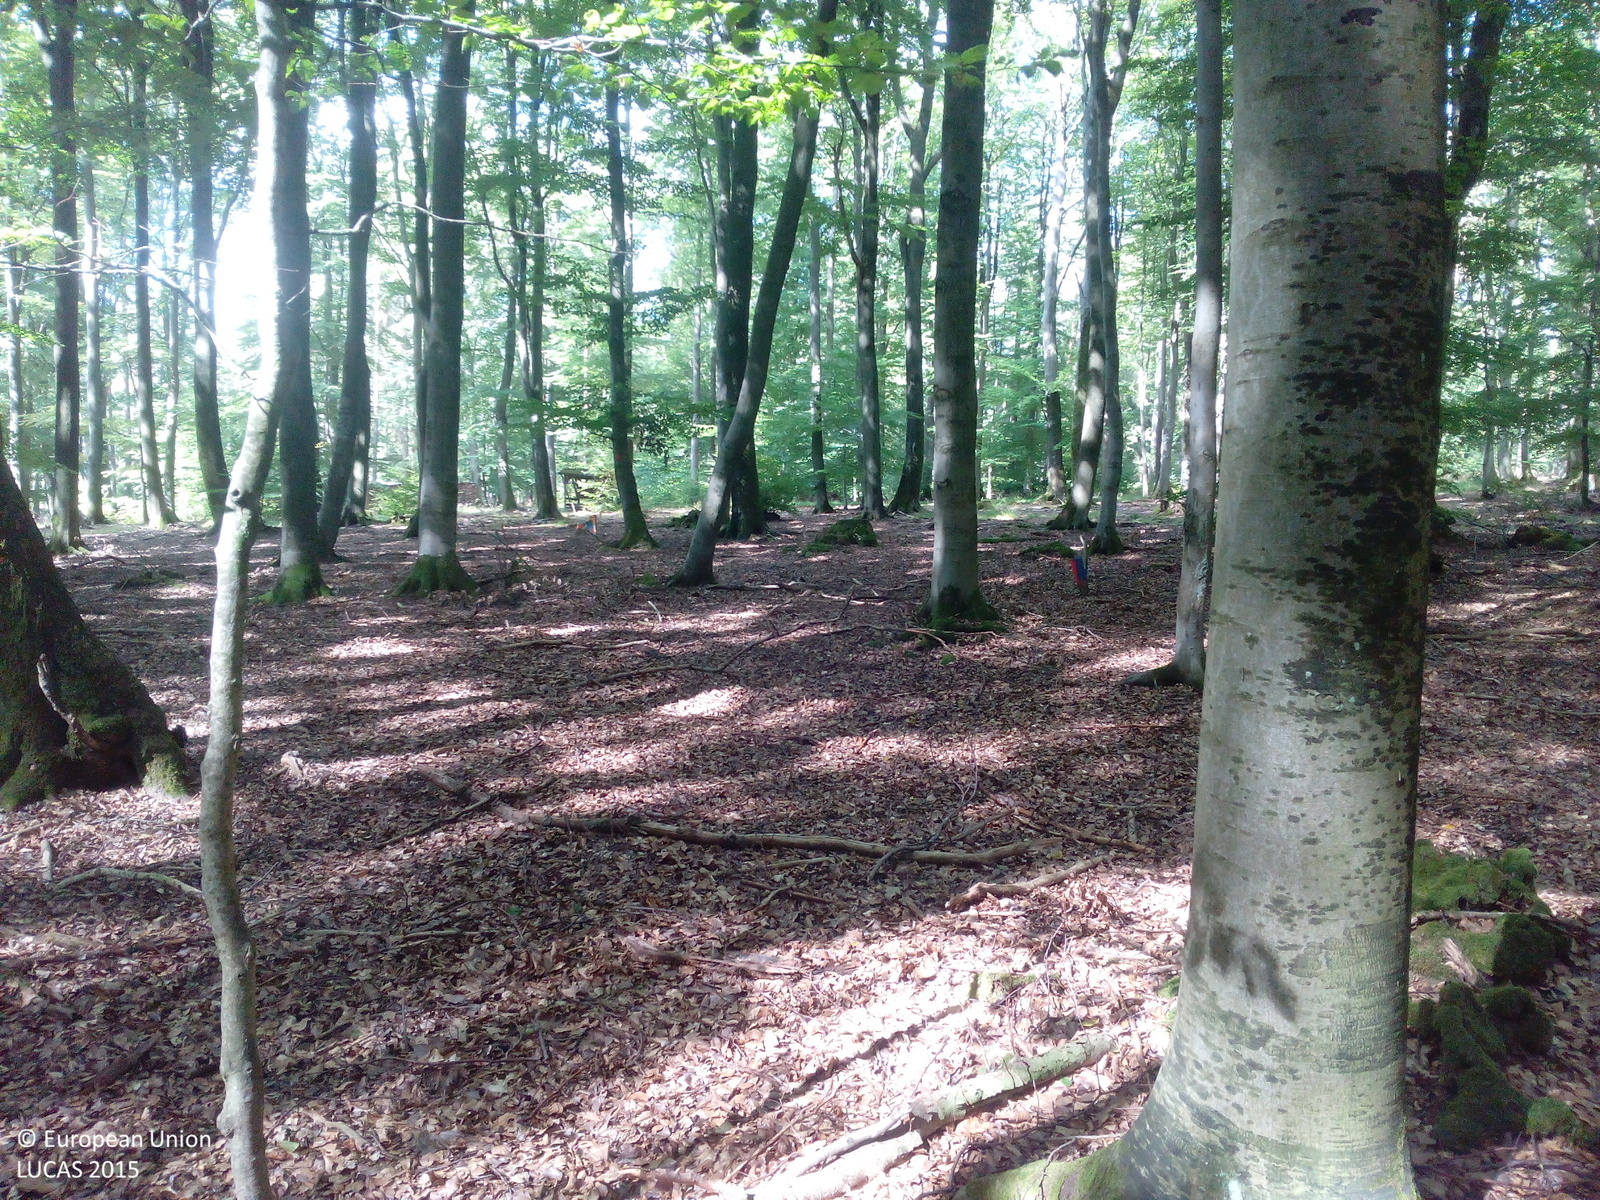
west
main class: Woodland
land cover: Broadleaved woodland
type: beech forest
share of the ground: > 75 %
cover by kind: broadleaved forest trees 90 %, unconsolidated bare surface 10 %
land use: Forestry
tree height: > 5 m
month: September
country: DE
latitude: 49.9496
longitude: 9.5681
